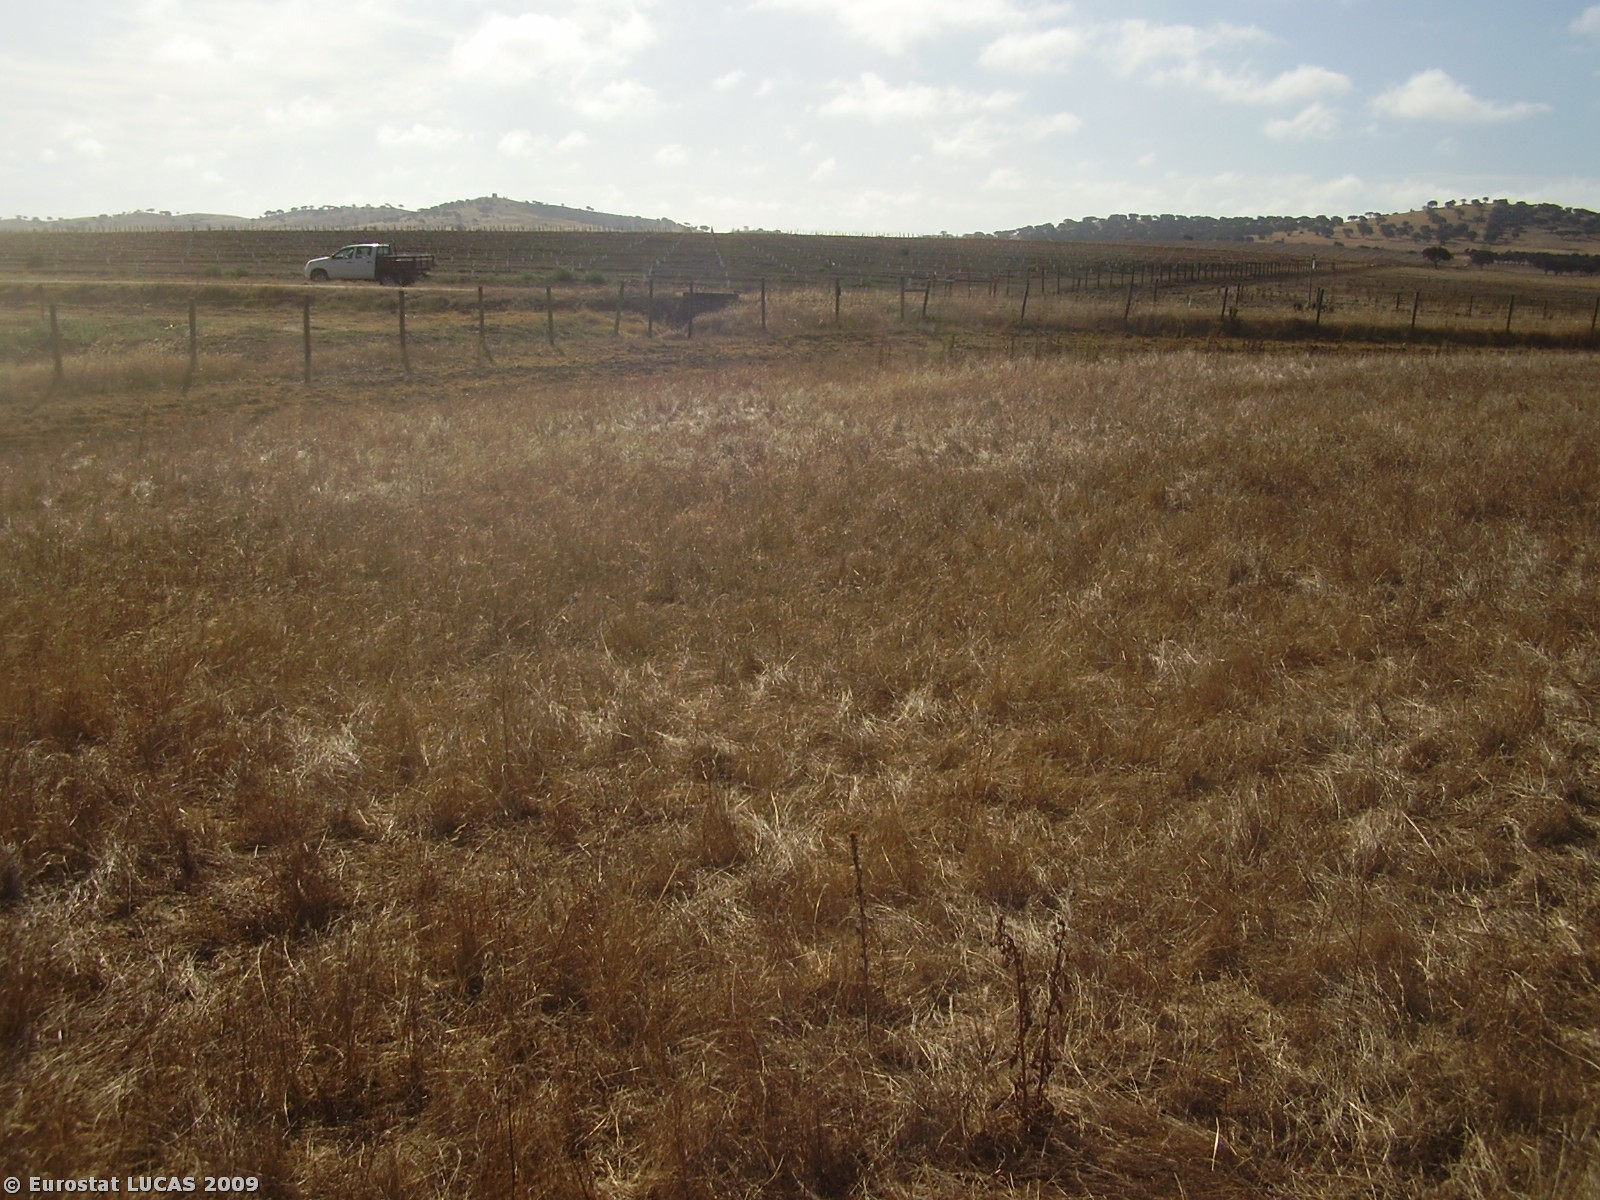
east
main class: Grassland
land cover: Grassland with sparse tree/shrub cover
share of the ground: > 75 %
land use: Fallow land
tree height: > 5 m
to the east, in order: Grassland with sparse tree/shrub cover; Fences; Ditches and canals; Spontaneously vegetated surfaces; Ditches and canals; Grass margins; Paved roads, cycling and walking lanes; Grass margins; Ditches and canals; Tracks; Olive groves
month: August
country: PT
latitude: 38.1114
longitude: -7.9726
